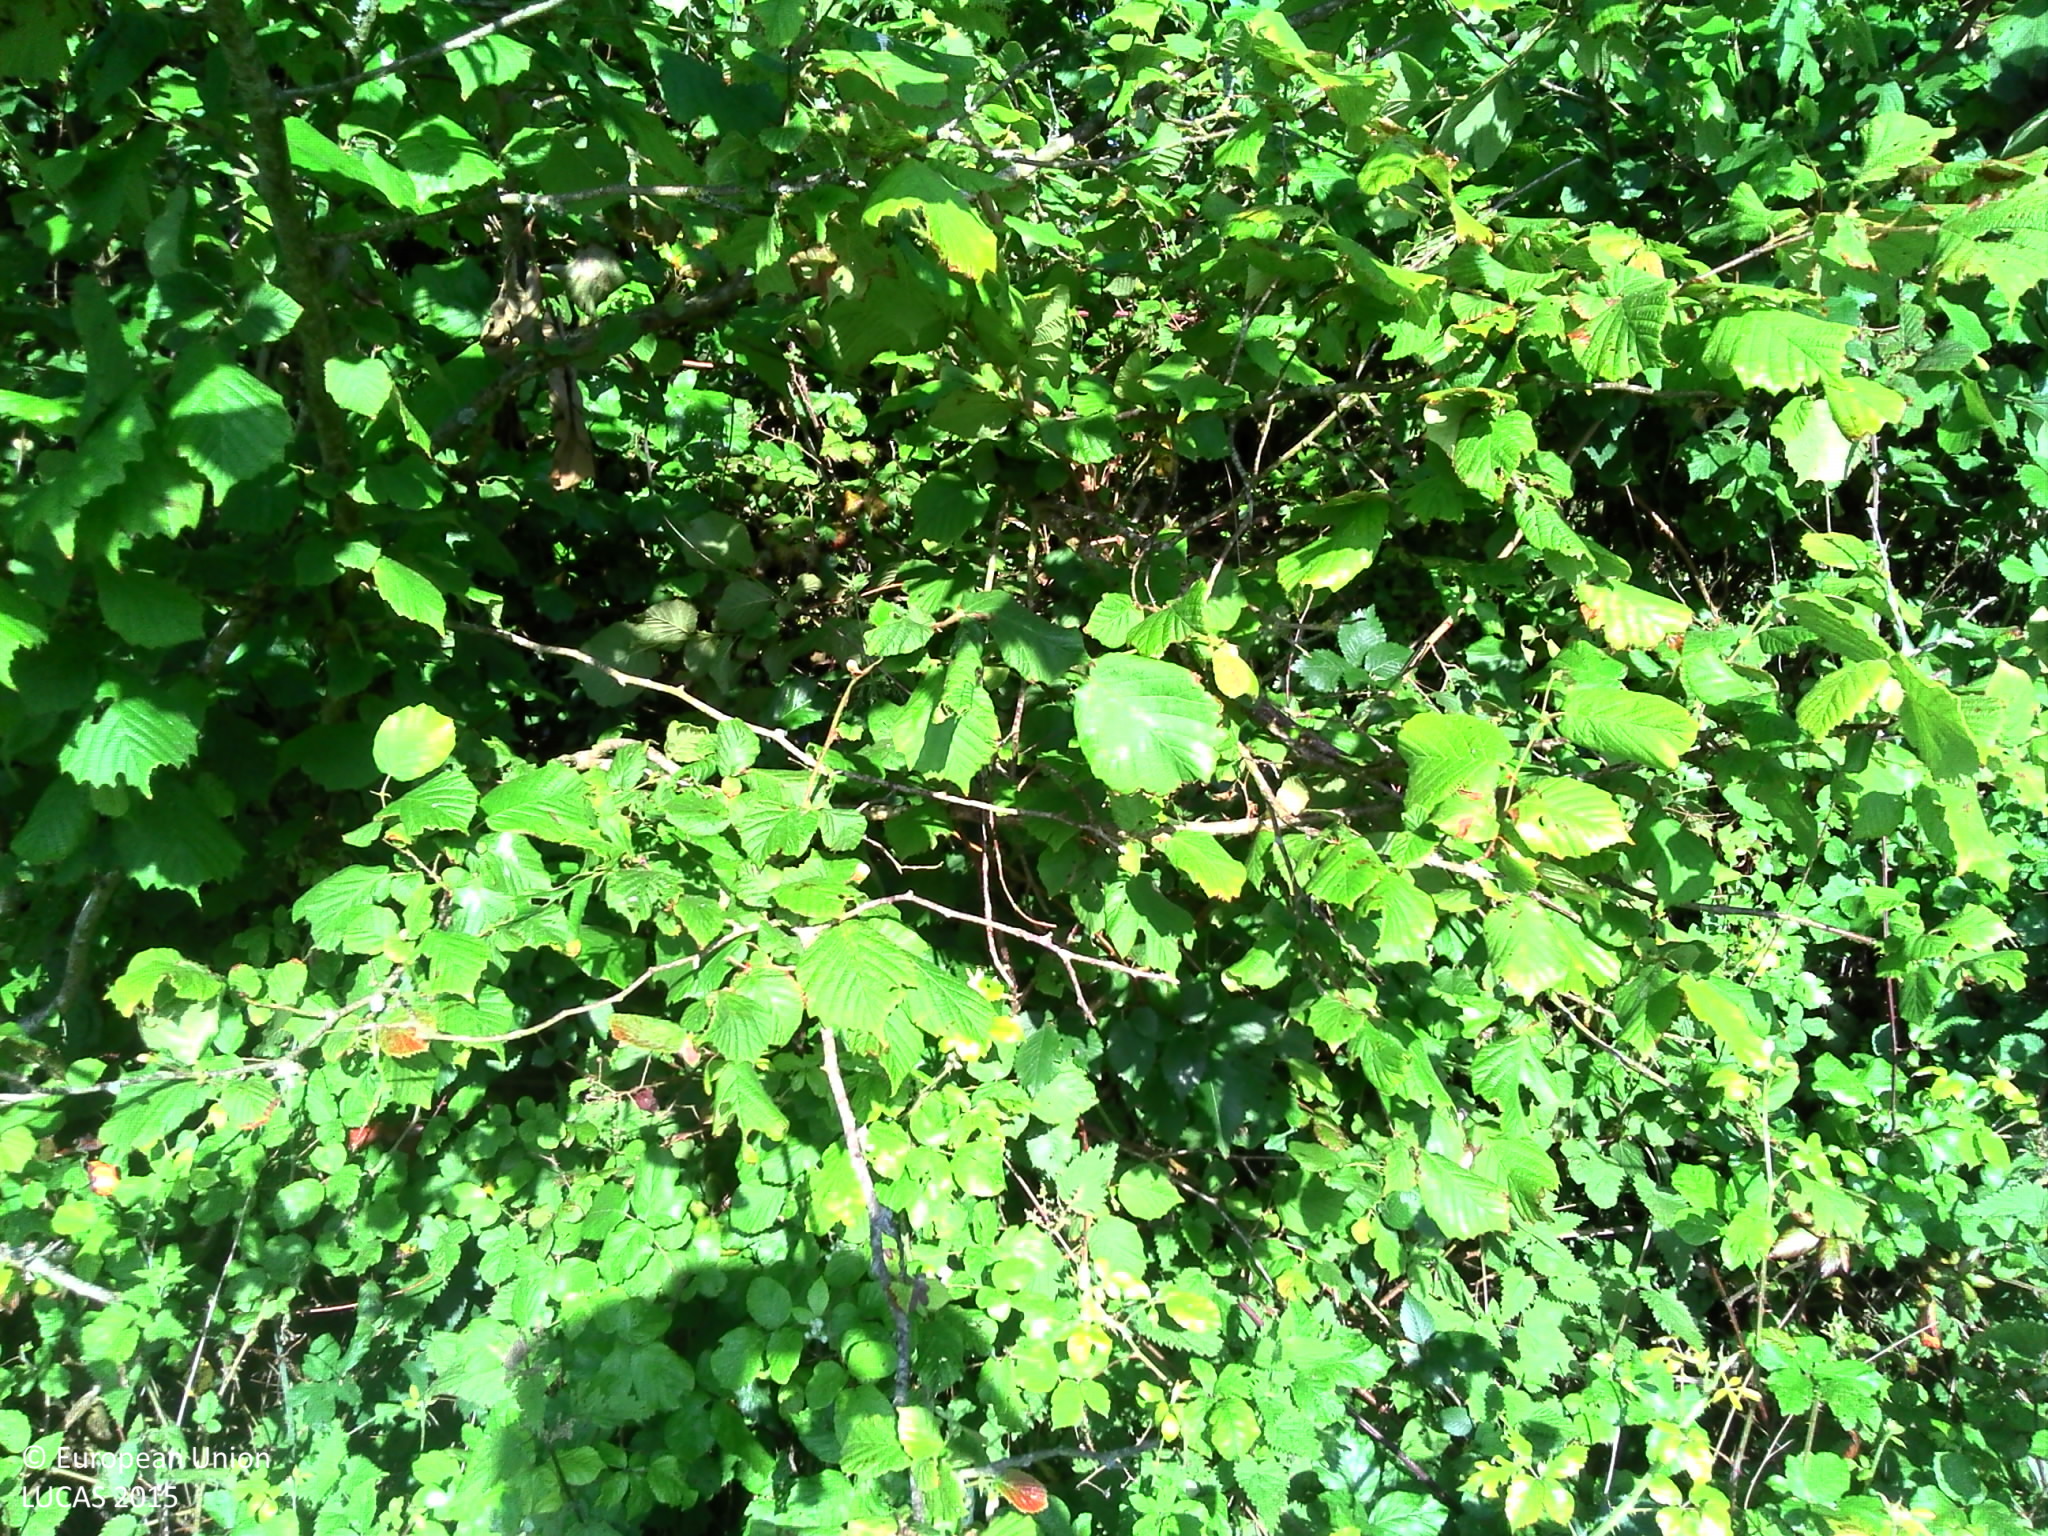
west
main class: Grassland
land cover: Grassland without tree/shrub cover
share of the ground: > 75 %
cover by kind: herbaceous plants 100 %
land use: Agriculture (excluding fallow land and kitchen gardens)
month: June
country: FR
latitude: 49.3349
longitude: -1.4290
